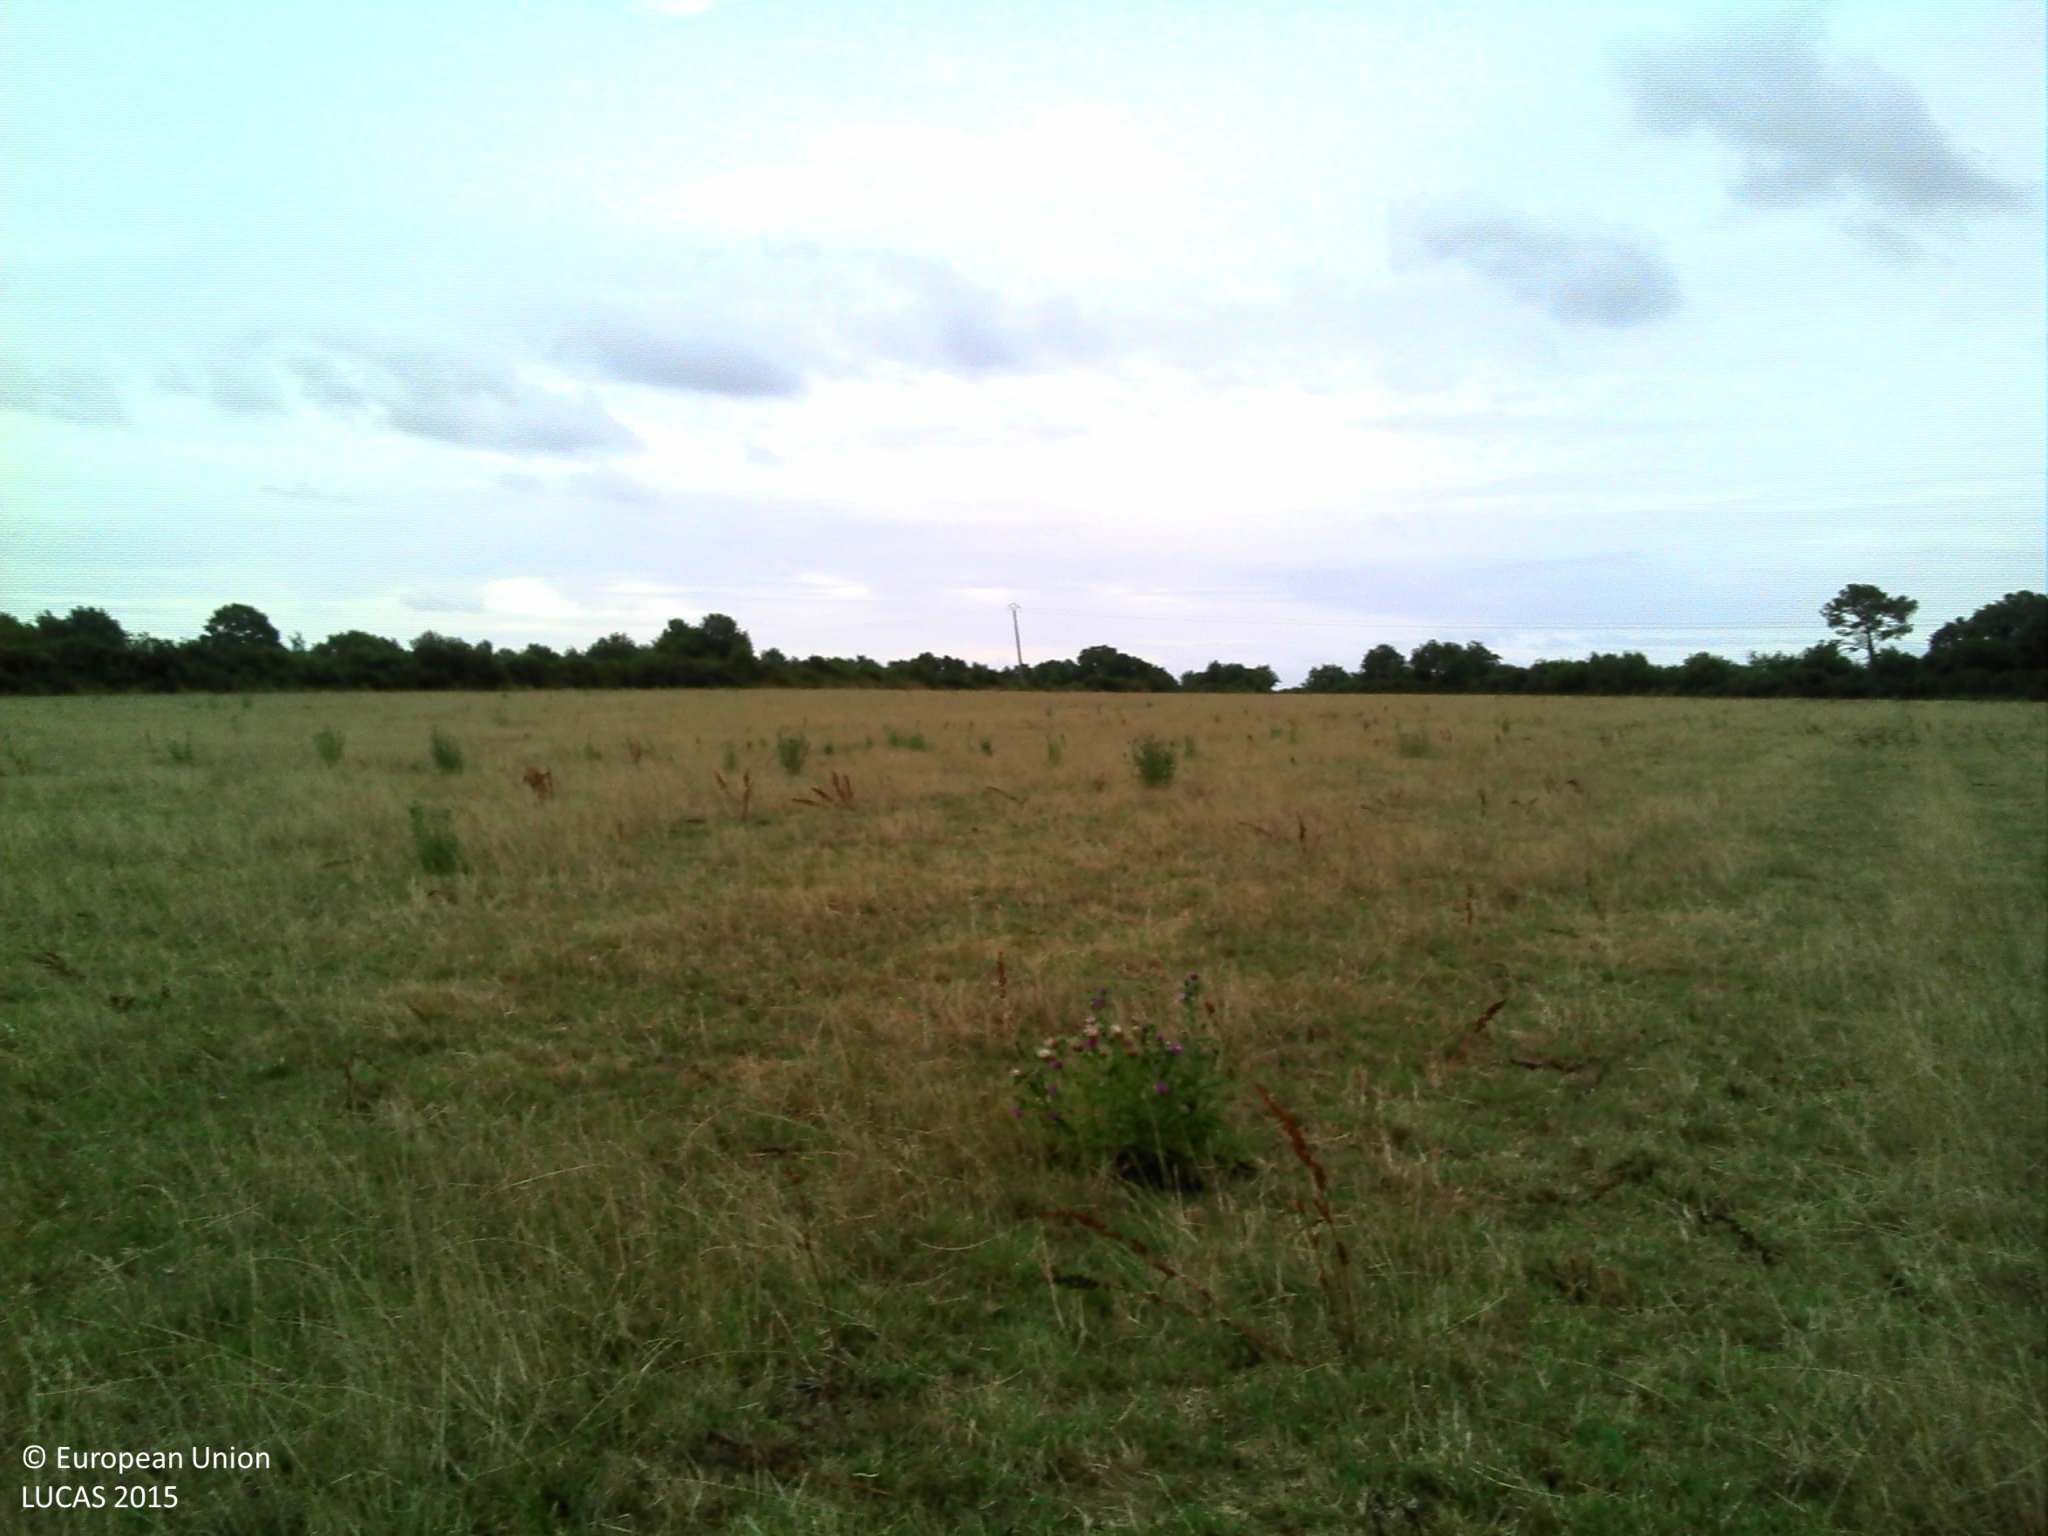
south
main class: Cropland
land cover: Temporary grasslands
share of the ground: > 75 %
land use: Agriculture (excluding fallow land and kitchen gardens)
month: July
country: FR
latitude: 47.7233
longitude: -1.5497
